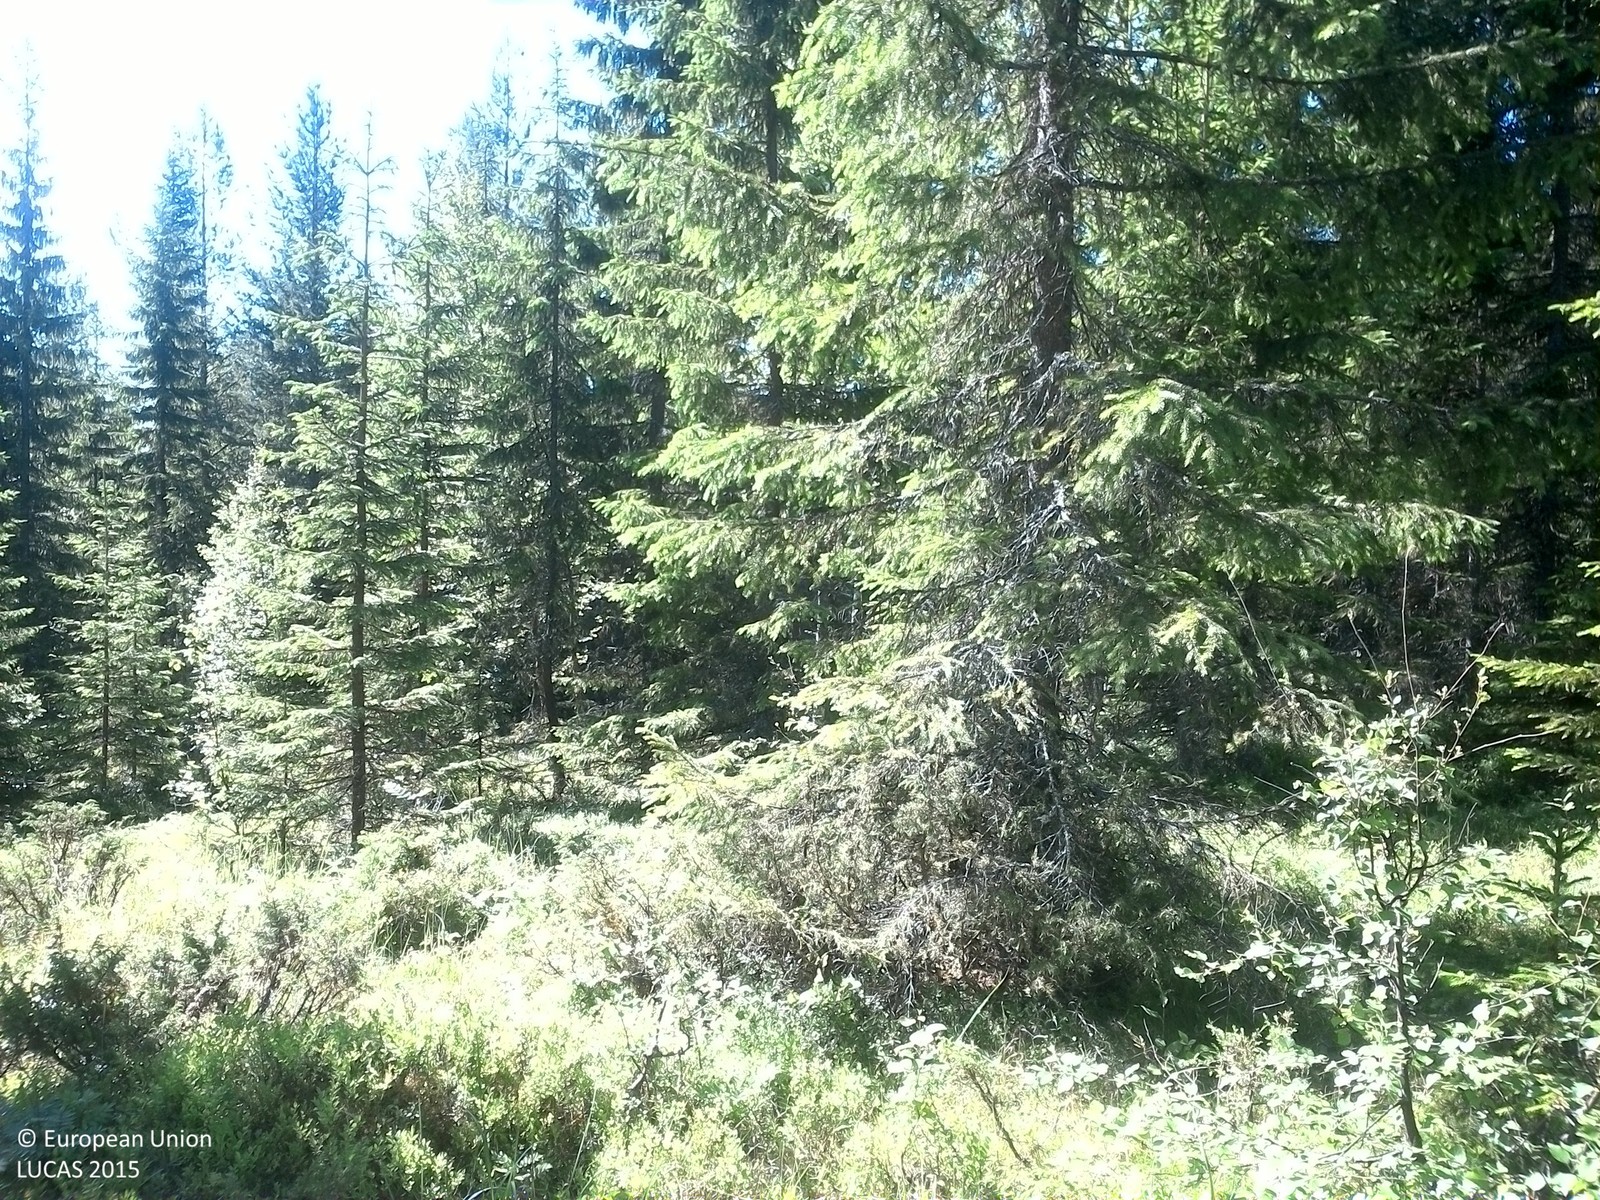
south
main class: Woodland
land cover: Spruce dominated coniferous woodland
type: boreal forest
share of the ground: 25 - 50 %
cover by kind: coniferous forest trees 40 %, herbaceous plants 30 %, shrubs 15 %, lichens and mosses 10 %, broadleaved forest trees 5 %
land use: Forestry
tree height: > 5 m
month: July
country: SE
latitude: 62.8007
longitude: 17.6069
